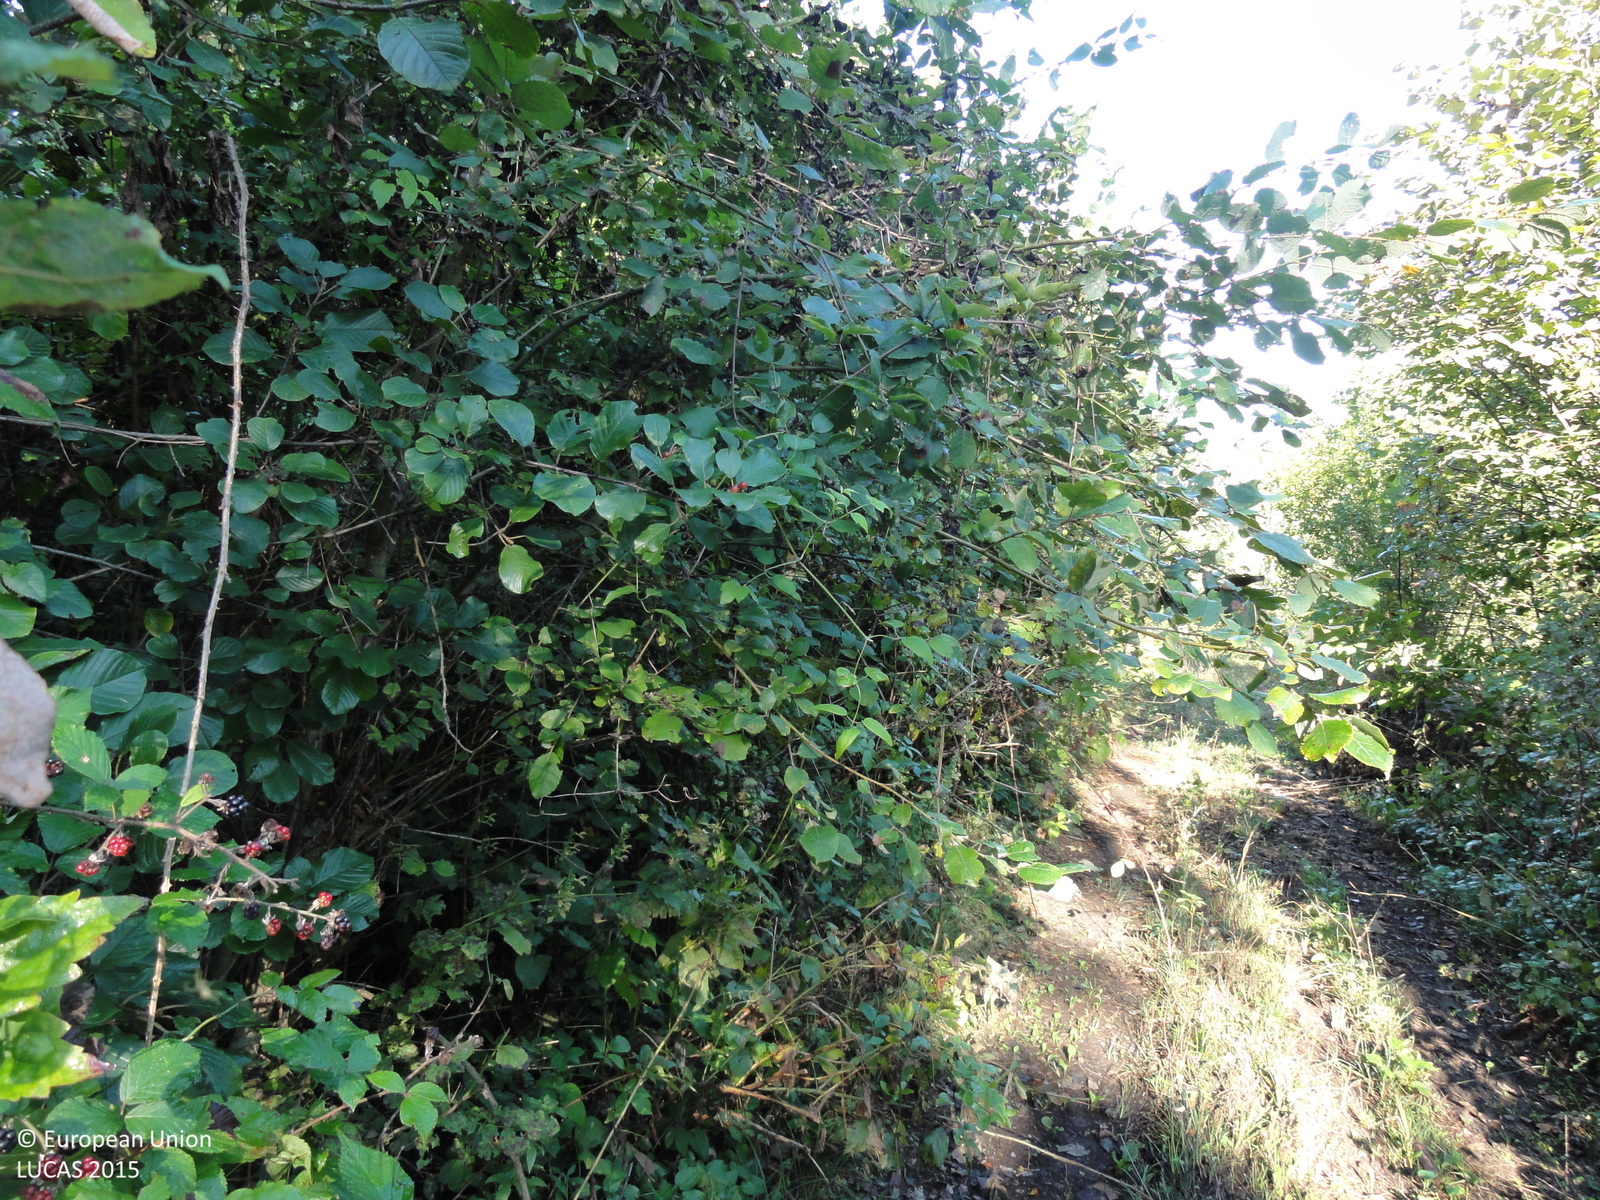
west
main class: Shrubland
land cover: Shrubland with sparse tree cover
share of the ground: > 75 %
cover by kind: shrubs 90 %, broadleaved forest trees 5 %, herbaceous plants 5 %
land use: Semi-natural and natural areas not in use
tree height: > 5 m
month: September
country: SI
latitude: 45.9400
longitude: 15.1175
